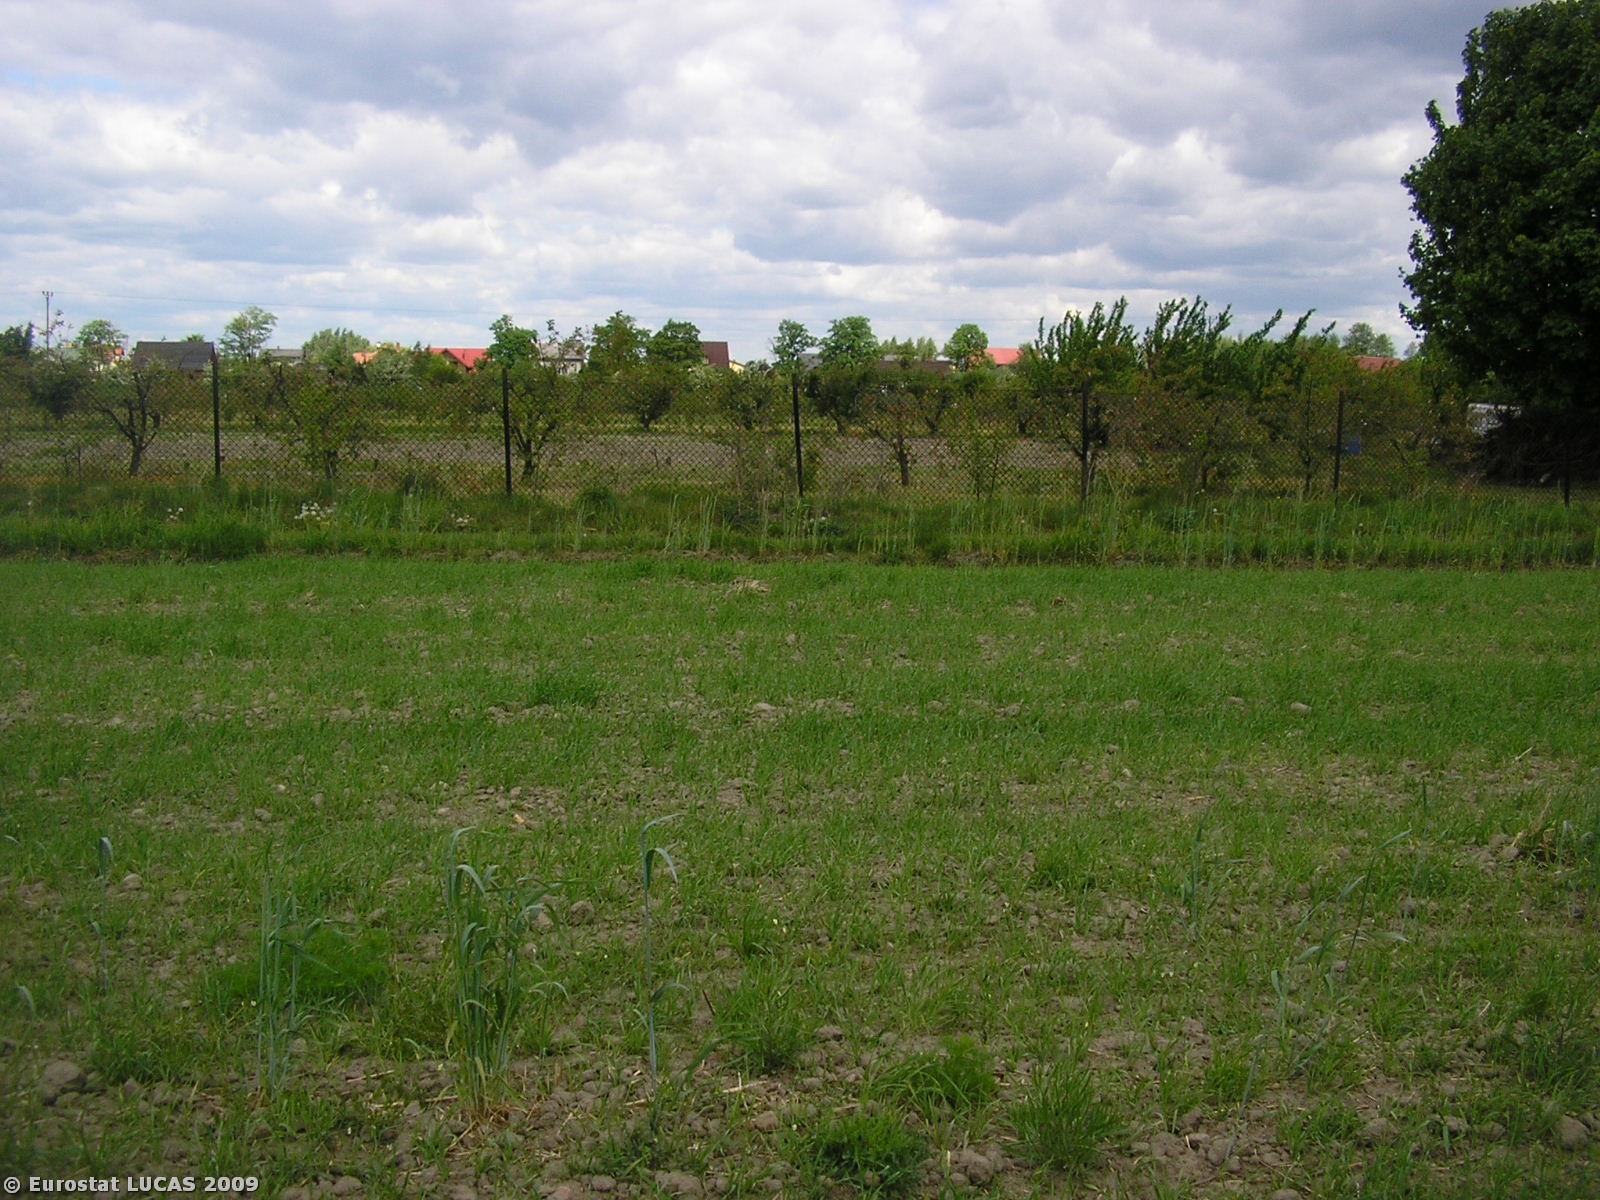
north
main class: Cropland
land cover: Barley
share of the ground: < 10 %
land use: Agriculture (excluding fallow land and kitchen gardens)
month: May
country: PL
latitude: 51.9621
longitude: 20.1196
